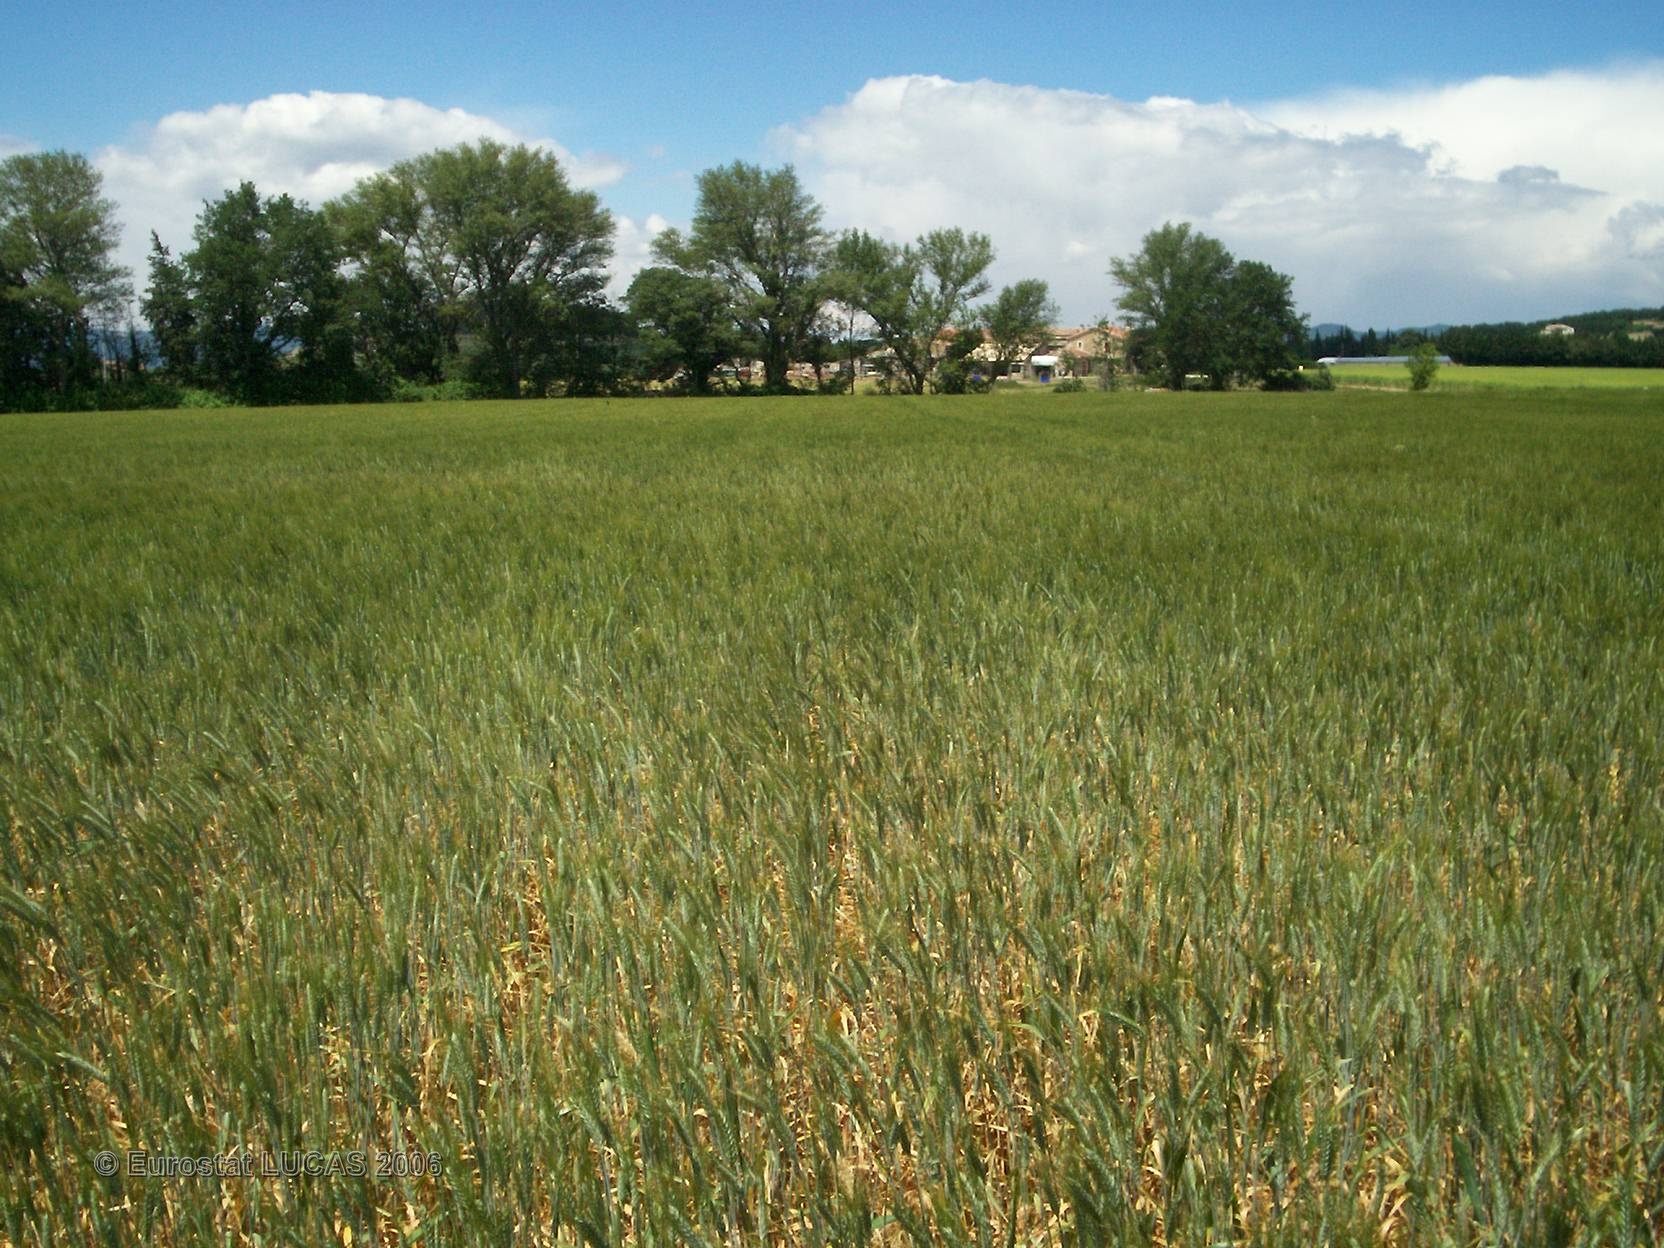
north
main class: Cropland
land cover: Durum wheat
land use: Agriculture (excluding fallow land and kitchen gardens)
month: May
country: FR
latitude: 44.5700
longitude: 4.9322
